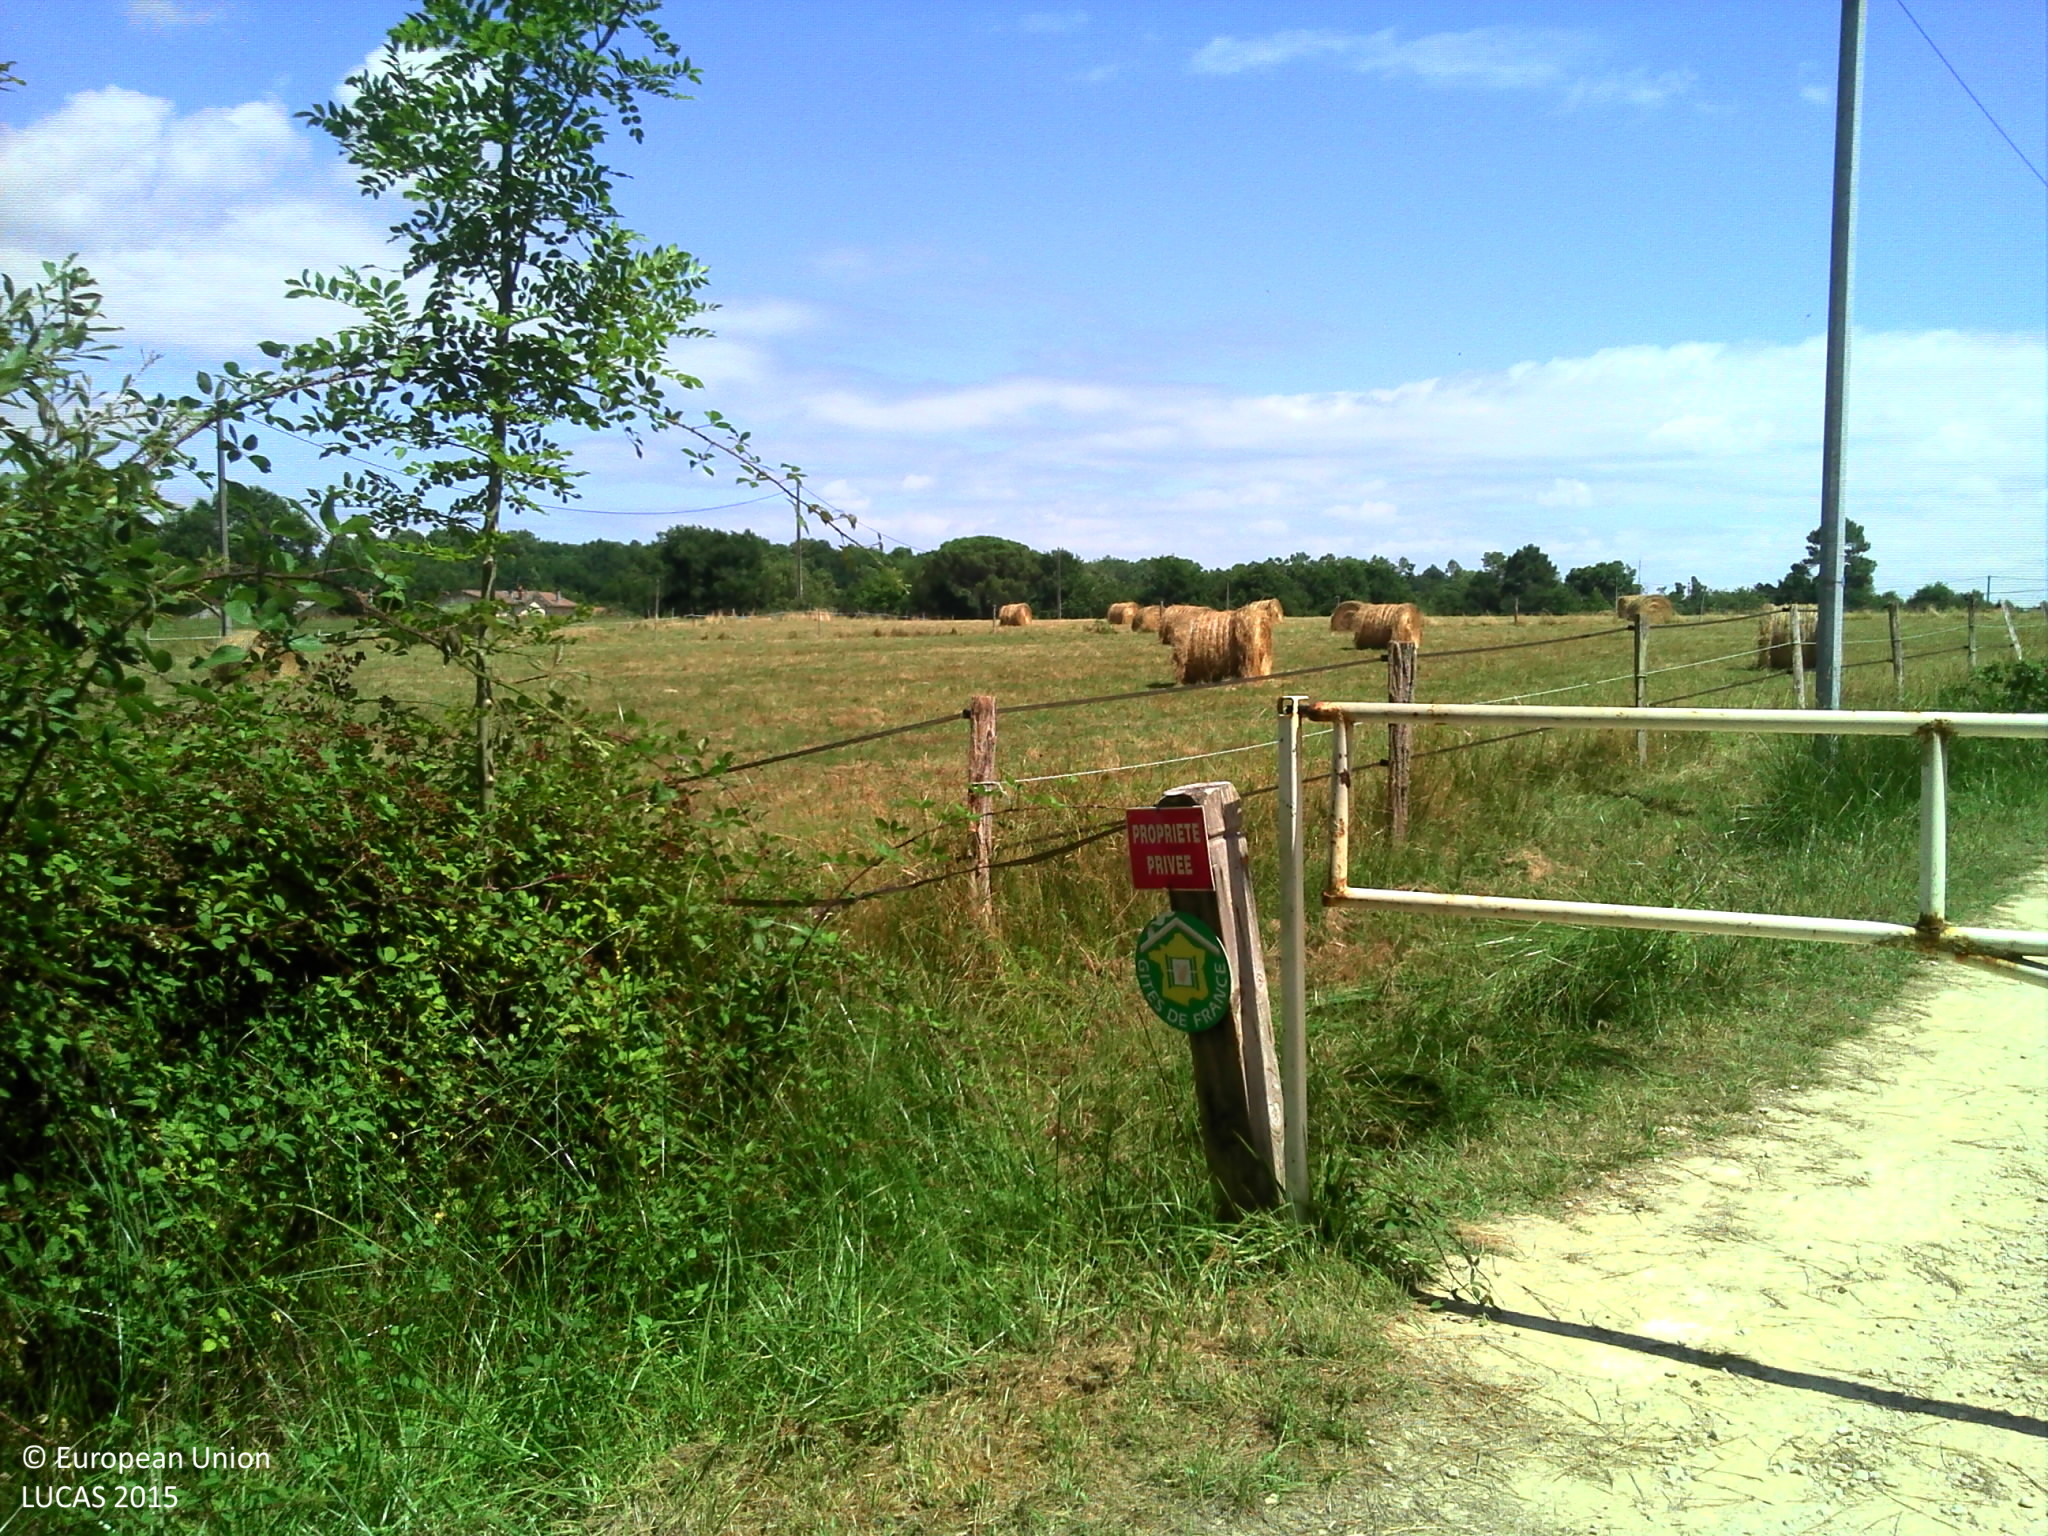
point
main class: Grassland
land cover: Grassland without tree/shrub cover
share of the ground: > 75 %
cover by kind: herbaceous plants 100 %
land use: Agriculture (excluding fallow land and kitchen gardens)
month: July
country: FR
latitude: 43.8682
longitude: -0.5266
